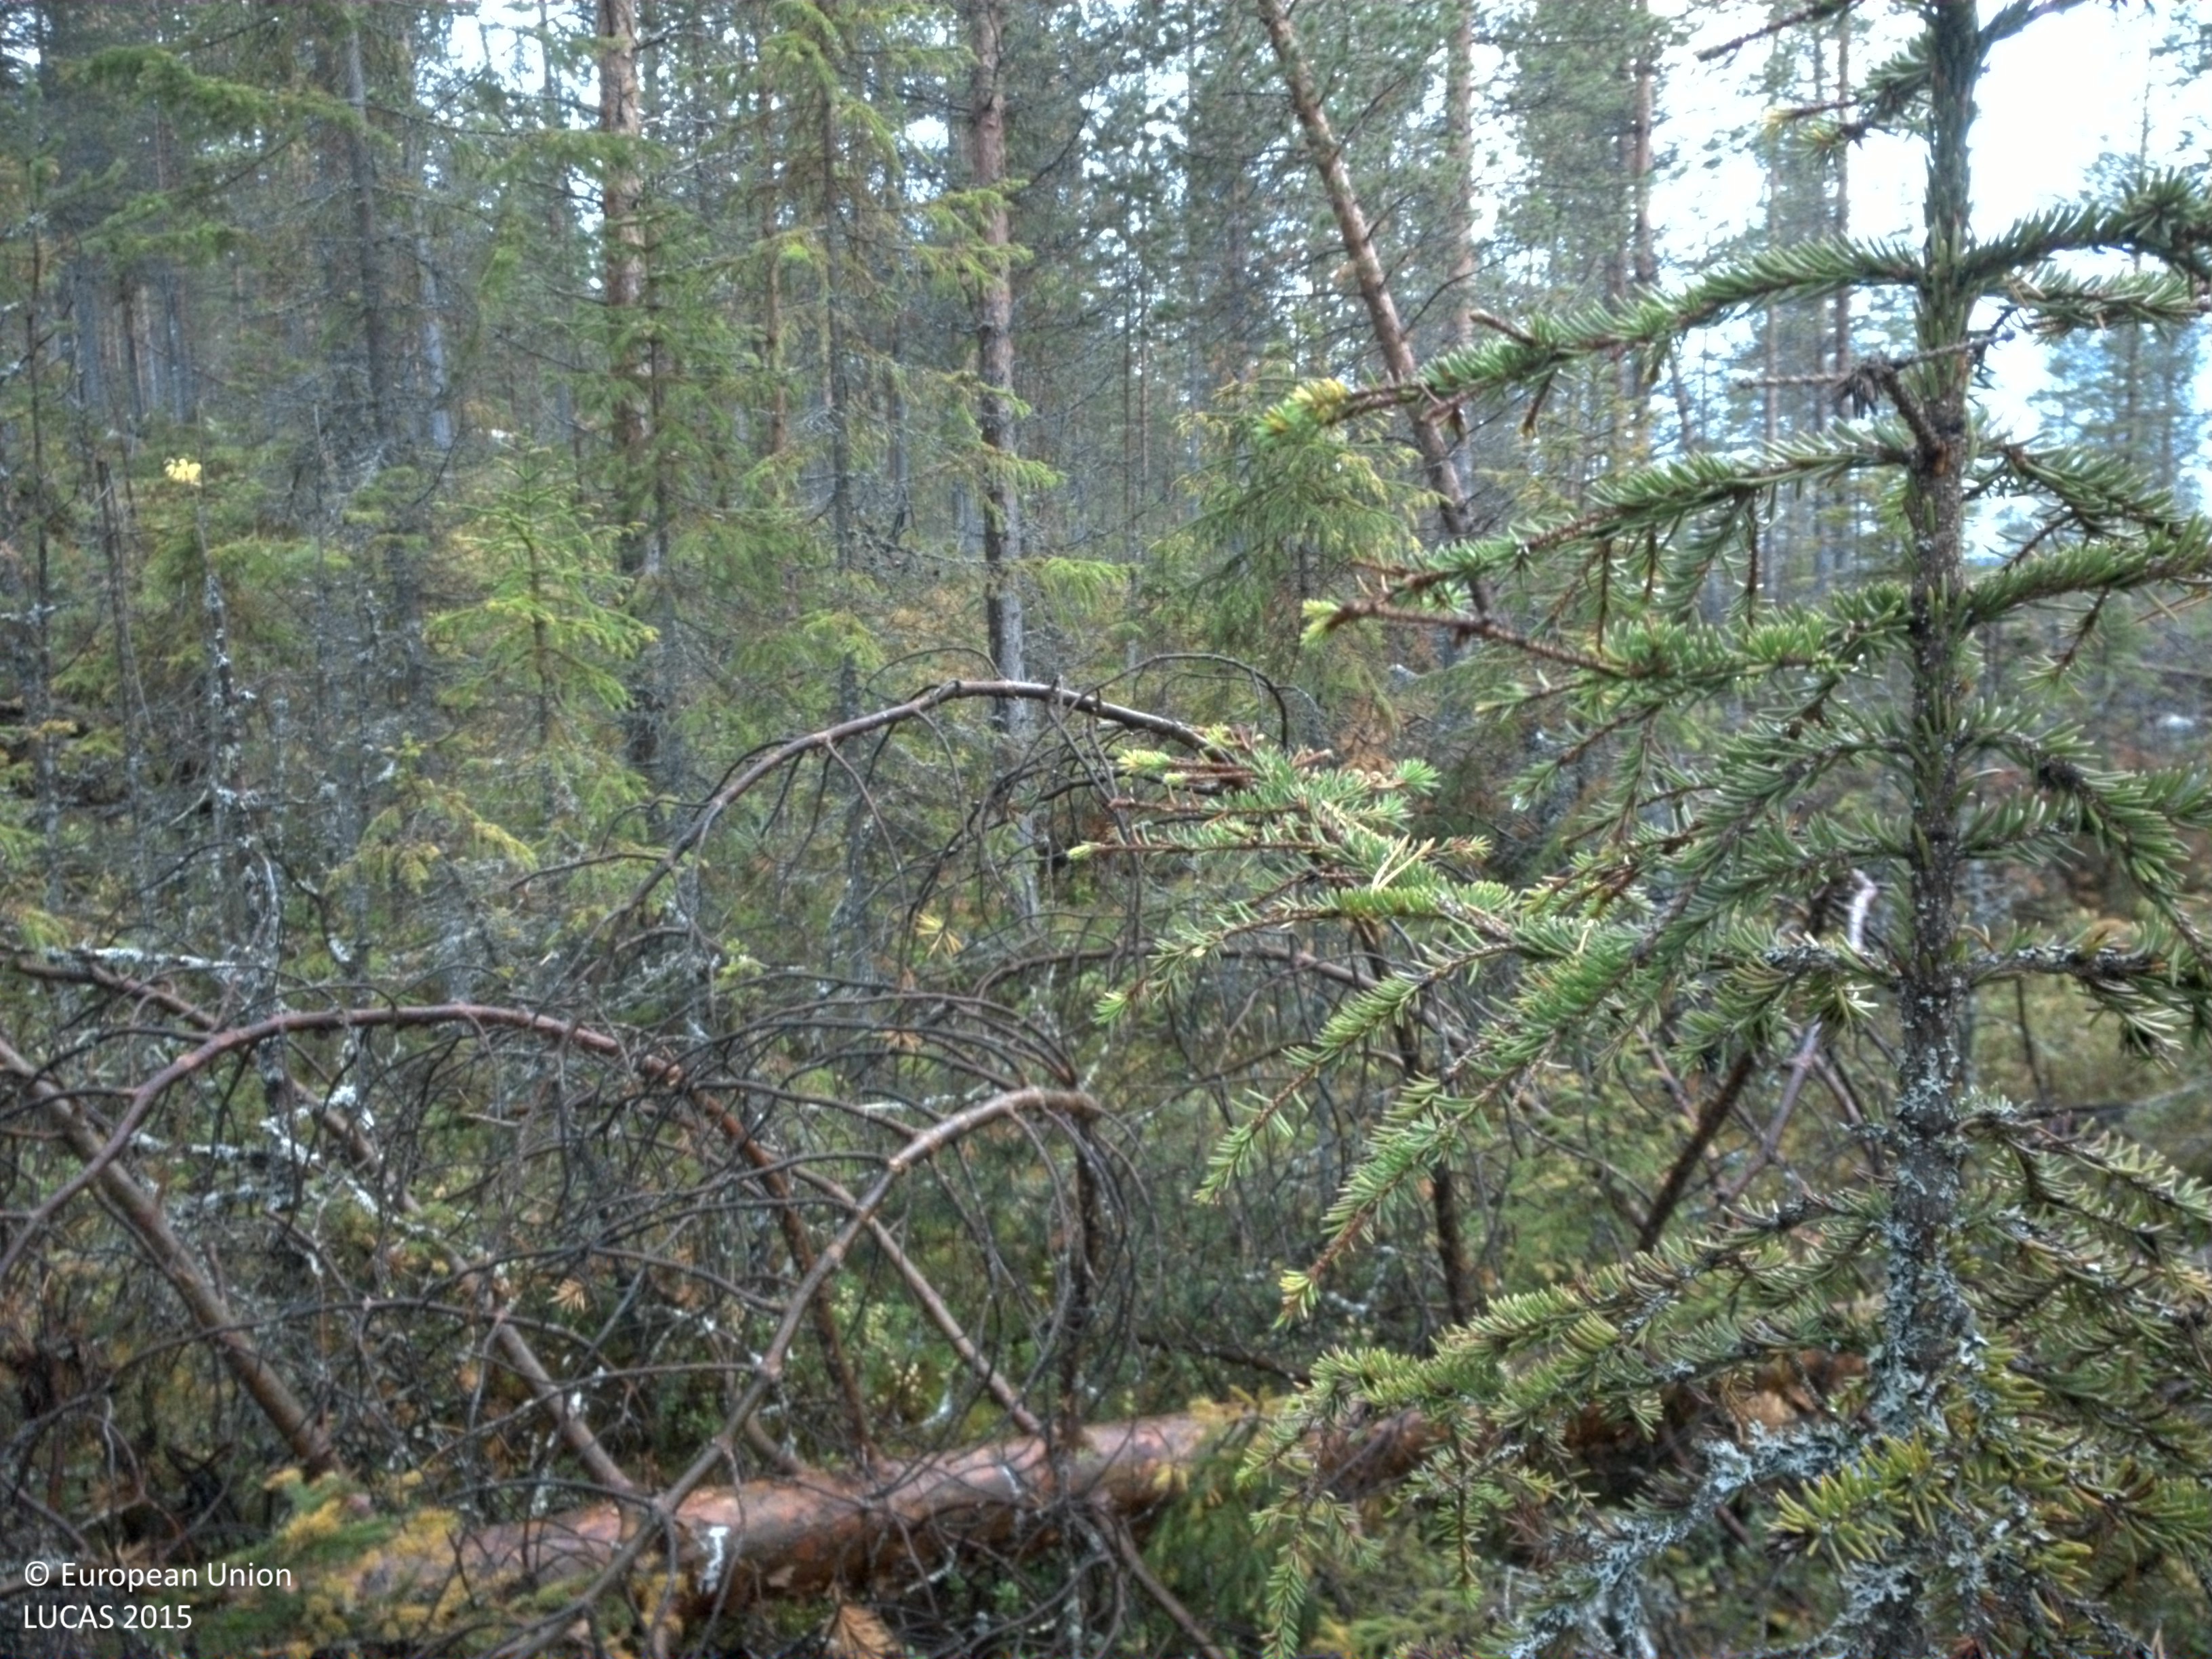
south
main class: Woodland
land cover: Other coniferous woodland
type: boreal forest
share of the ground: 25 - 50 %
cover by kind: coniferous forest trees 45 %, herbaceous plants 35 %, lichens and mosses 20 %
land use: Forestry
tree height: > 5 m
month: September
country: SE
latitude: 65.0876
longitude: 17.6011
